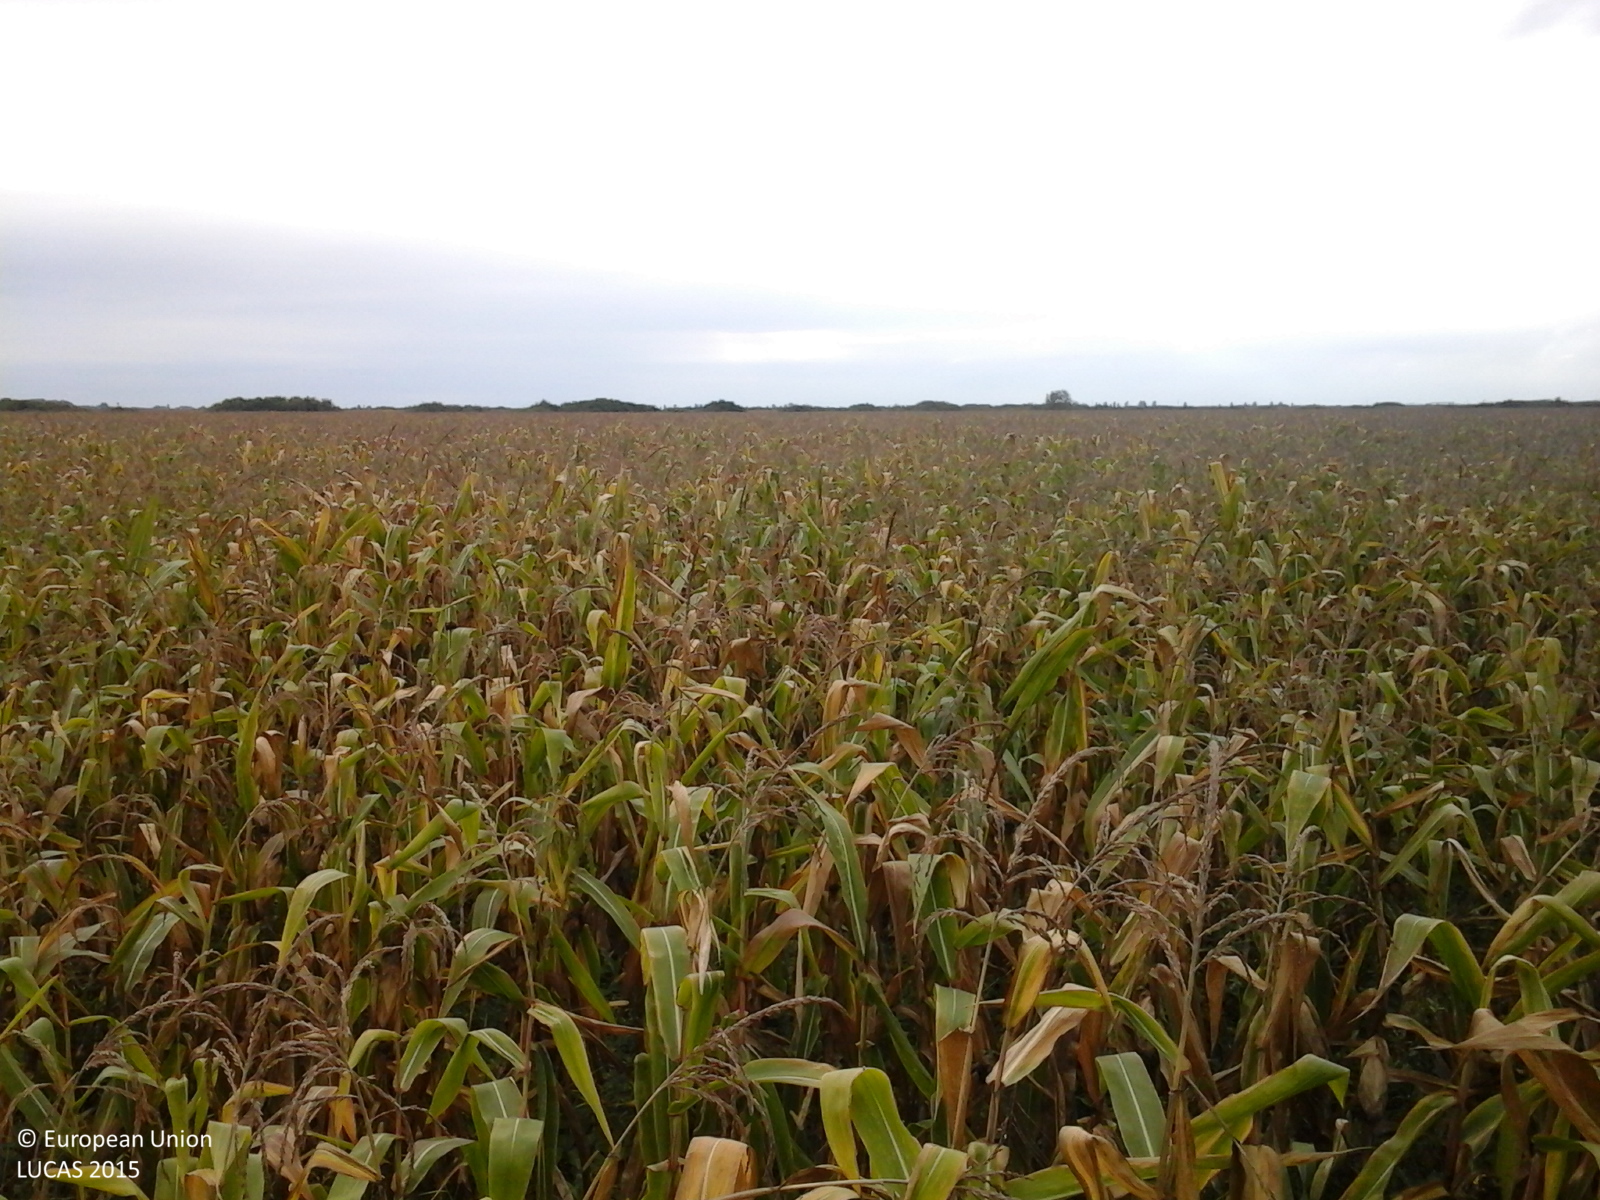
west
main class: Cropland
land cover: Maize
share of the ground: > 75 %
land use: Agriculture (excluding fallow land and kitchen gardens)
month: September
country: RO
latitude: 46.7552
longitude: 21.7594
